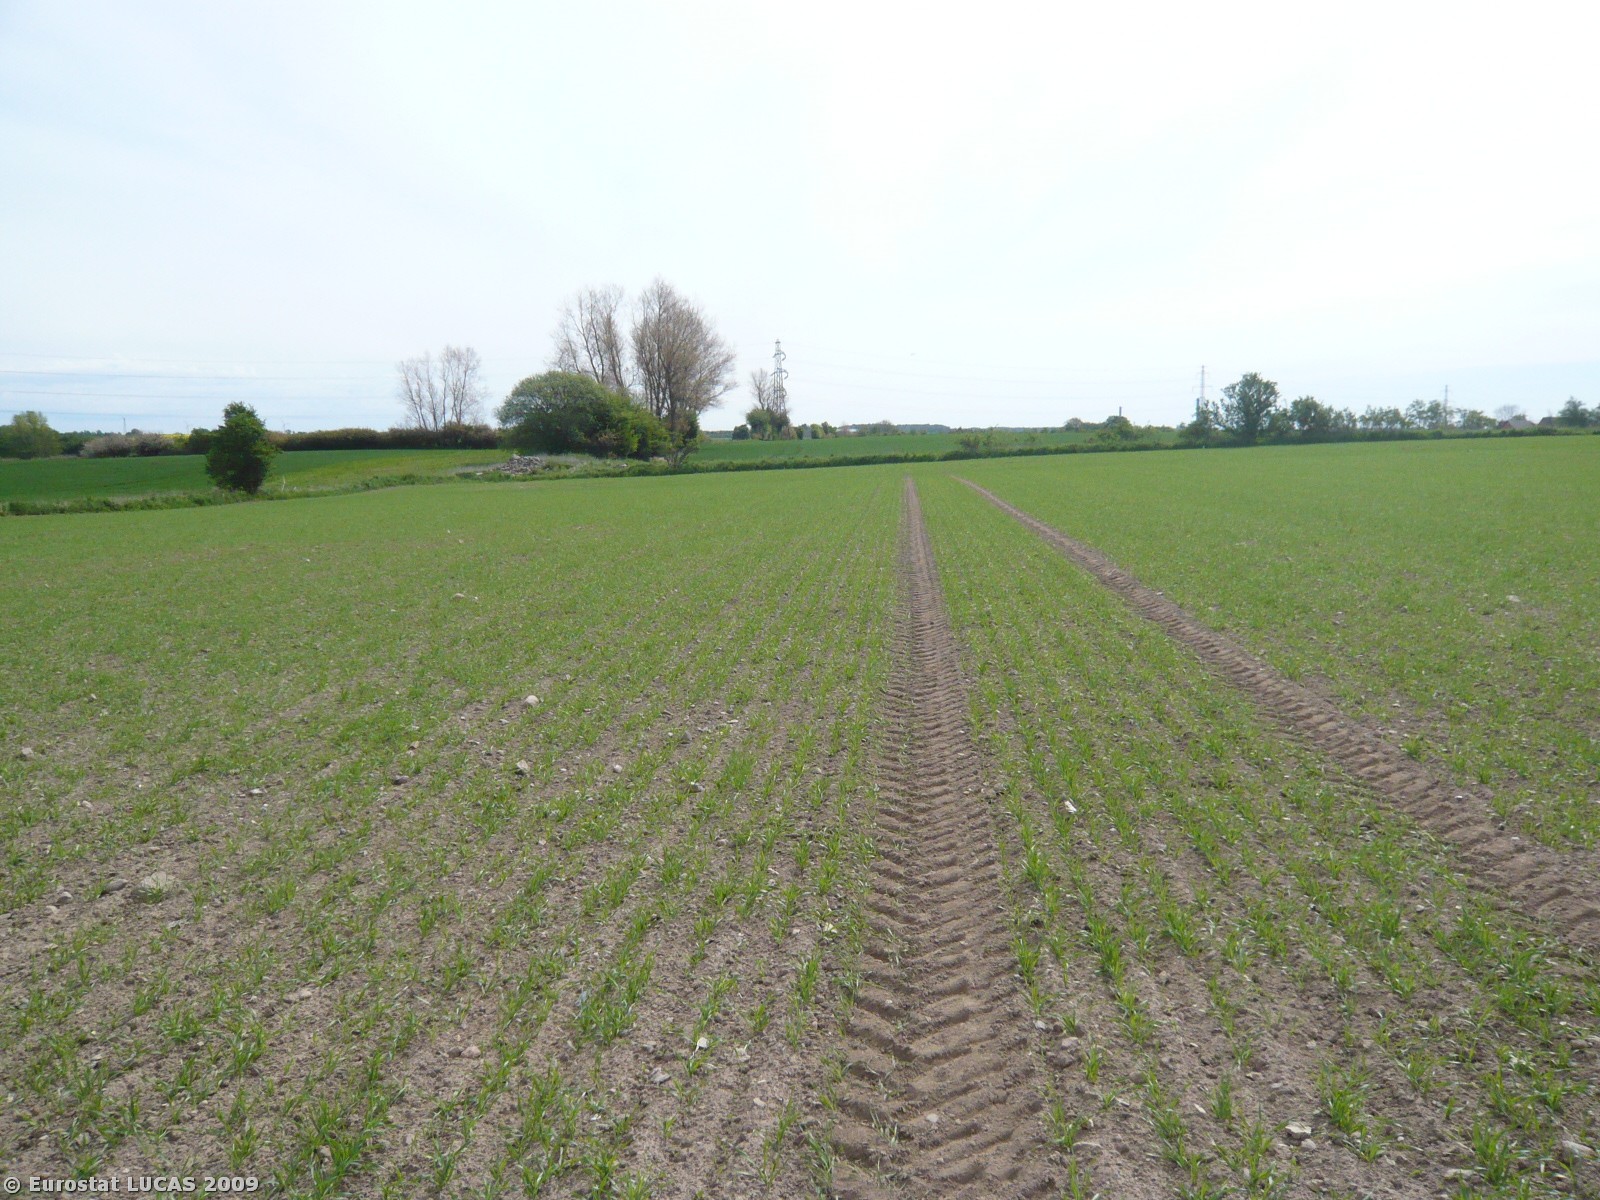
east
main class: Cropland
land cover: Common wheat
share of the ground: 25 - 50 %
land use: Agriculture (excluding fallow land and kitchen gardens)
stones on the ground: 10 - 25 %
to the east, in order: Common wheat; Grassland without tree/shrub cover; Common wheat; Dry stone walls; Grassland without tree/shrub cover; Dry stone walls; Broadleaved woodland; Barley
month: May
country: DK
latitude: 55.1489
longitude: 11.8973
